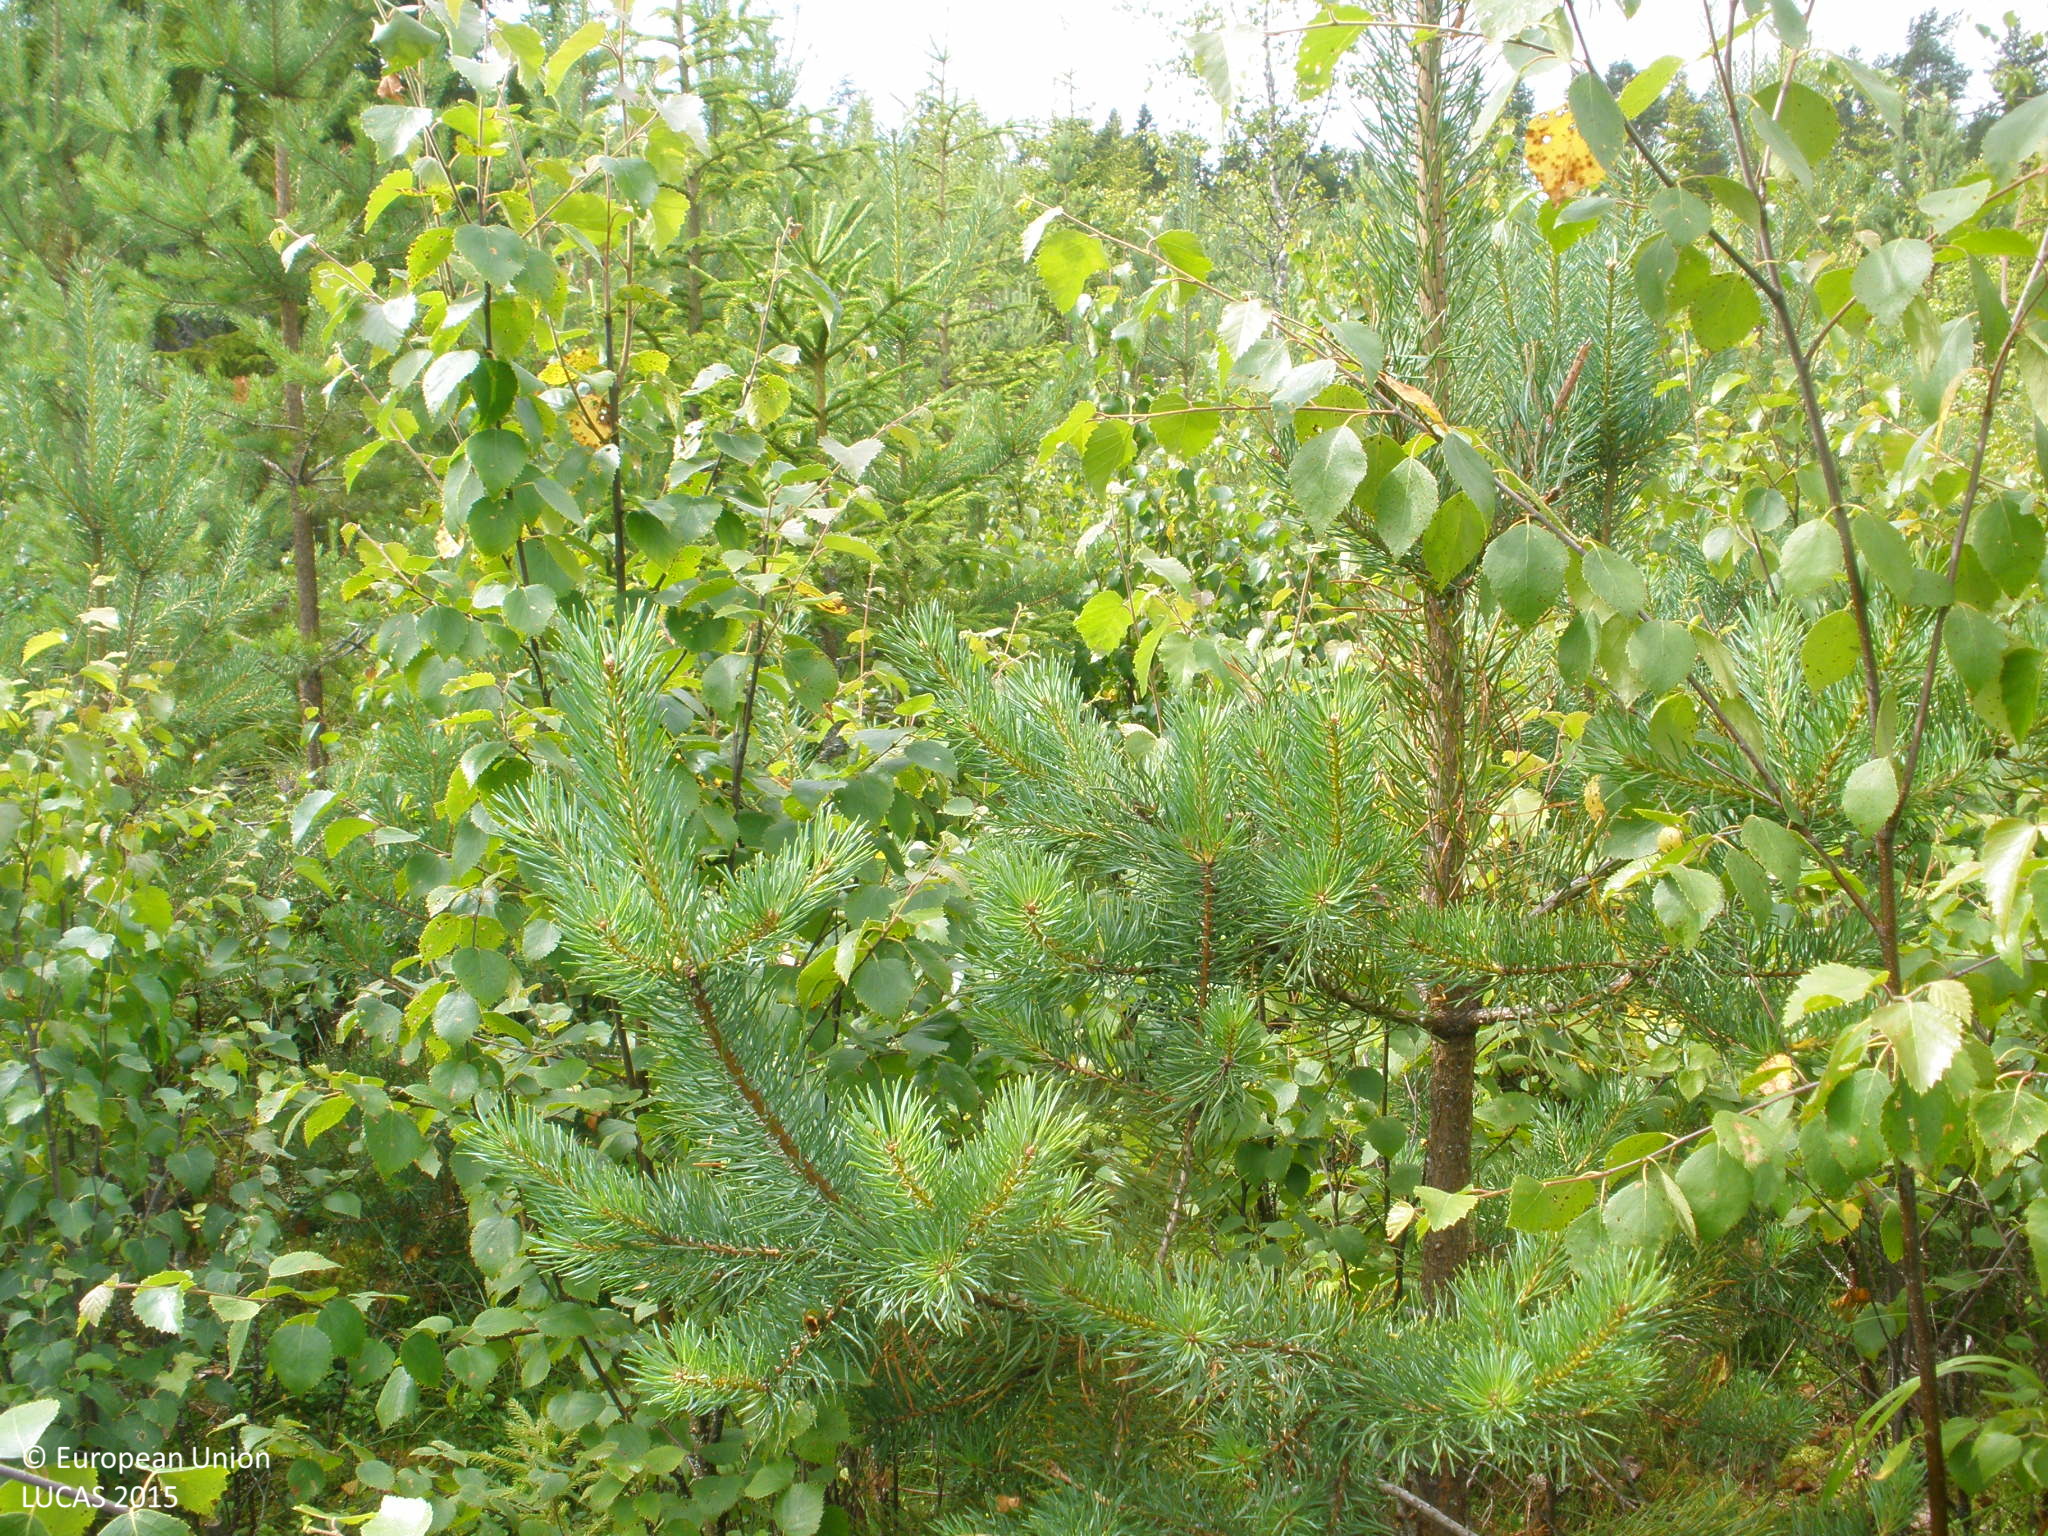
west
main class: Woodland
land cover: Pine dominated mixed woodland
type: boreal forest
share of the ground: 50 - 75 %
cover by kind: coniferous forest trees 35 %, broadleaved forest trees 35 %, shrubs 10 %, herbaceous plants 10 %, lichens and mosses 10 %
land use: Forestry
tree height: < 5 m
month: July
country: FI
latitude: 60.8817
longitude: 24.0774
